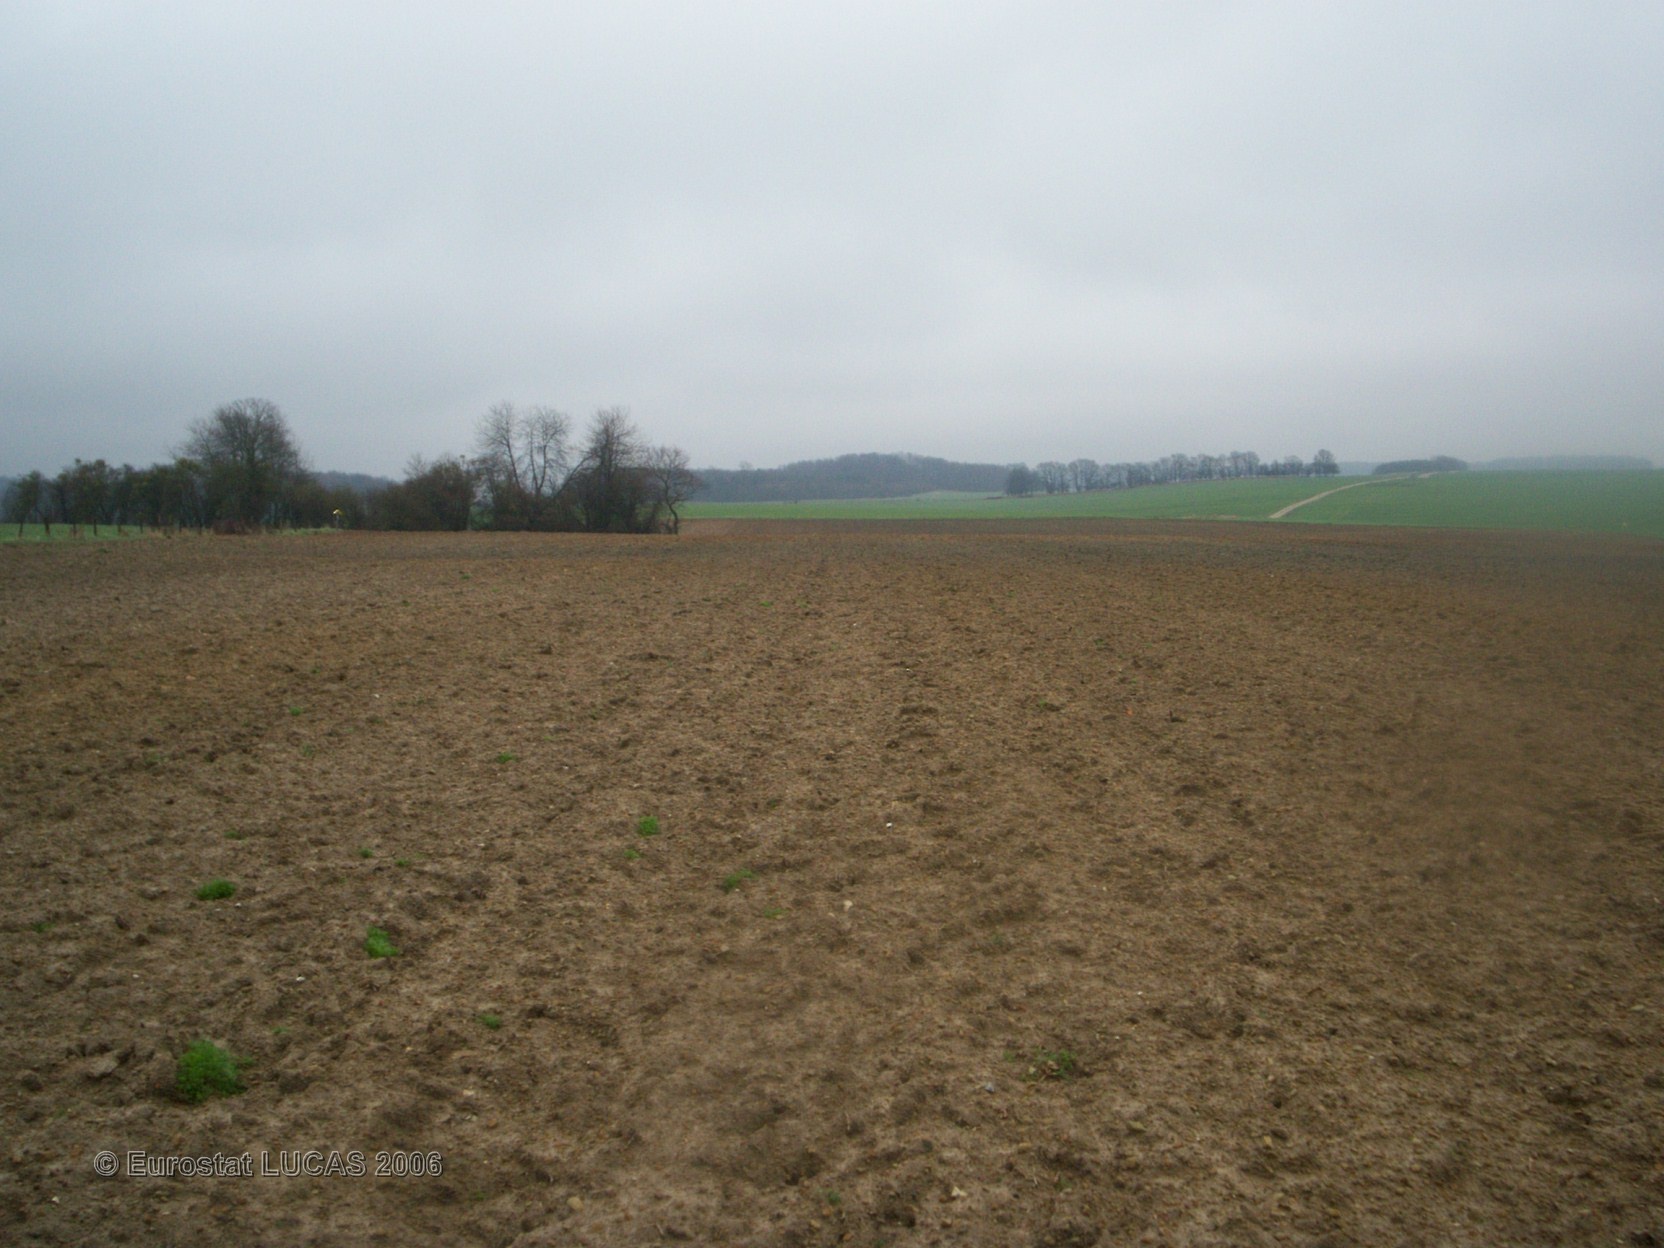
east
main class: Cropland
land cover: Maize
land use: Agriculture (excluding fallow land and kitchen gardens)
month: June
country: FR
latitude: 49.1589
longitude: 5.0751
